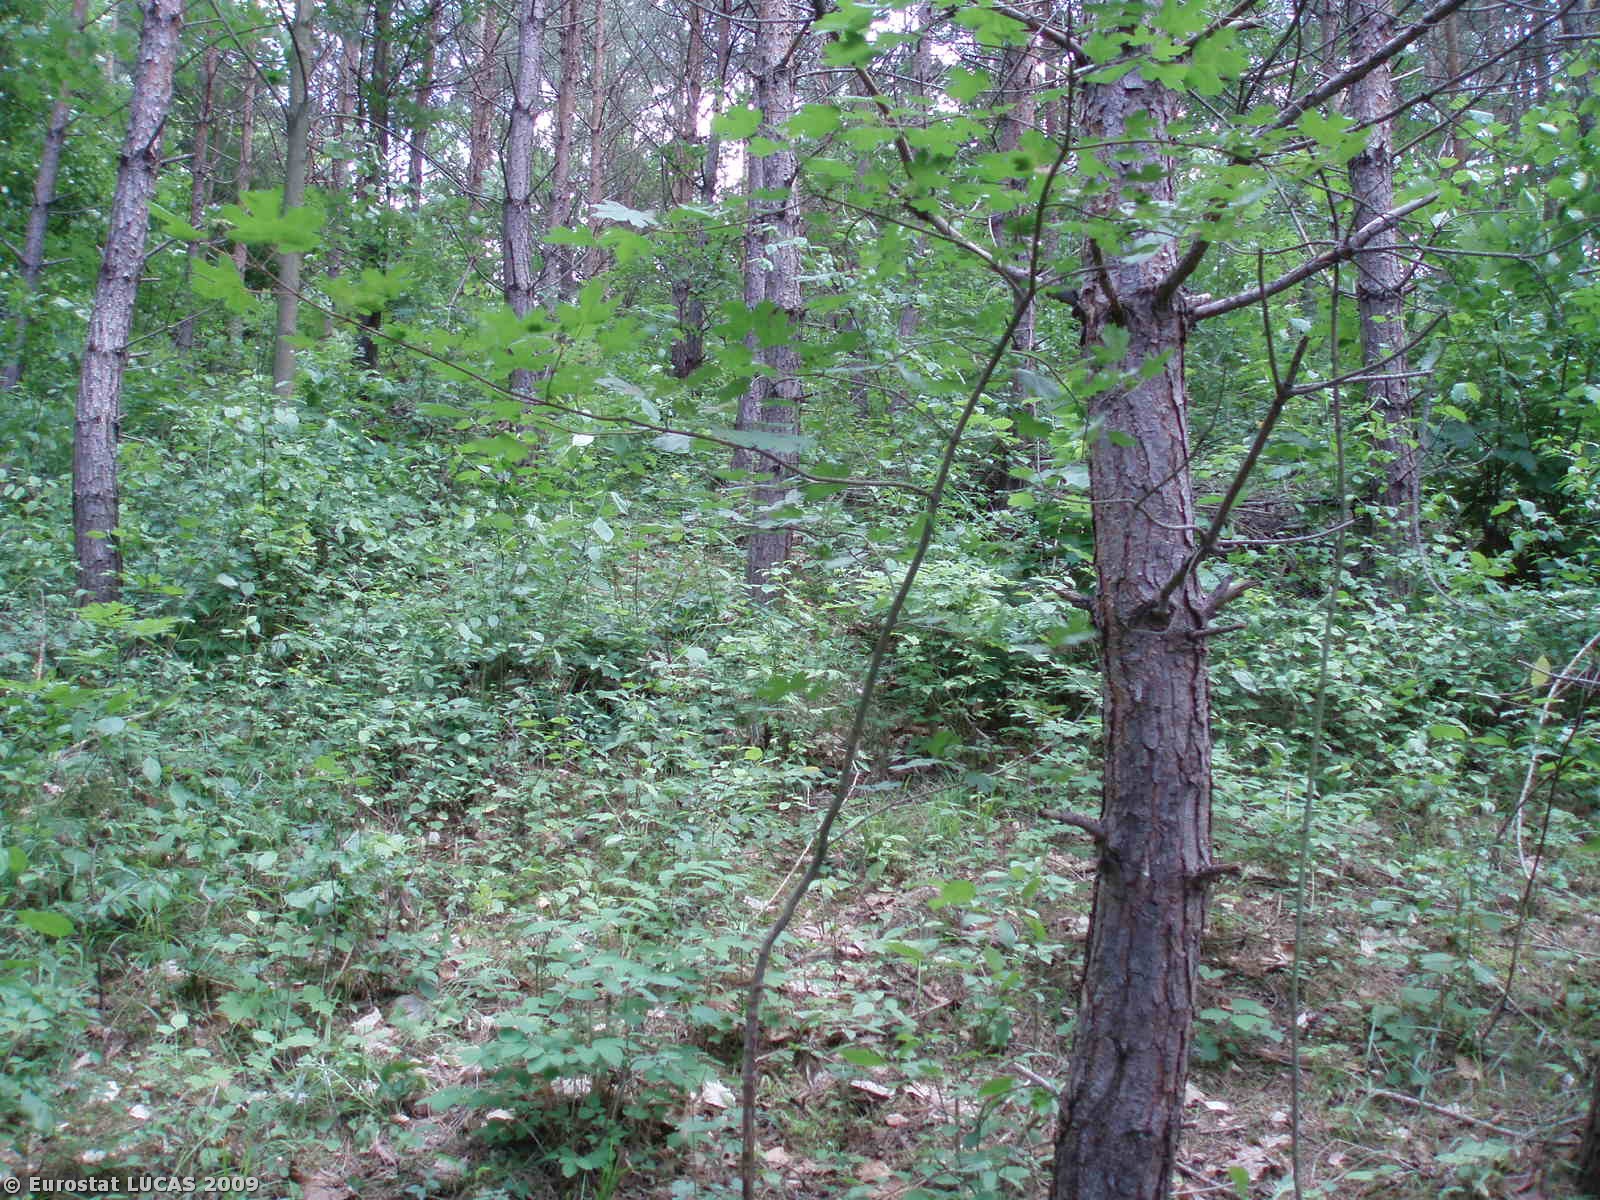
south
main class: Woodland
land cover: Coniferous woodland
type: hemiboreal forest and nemoral coniferous forest and mixed broadleaved-coniferous forest
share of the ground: > 75 %
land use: Forestry
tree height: > 5 m
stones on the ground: < 10 %
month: May
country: CZ
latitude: 49.9609
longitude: 14.2529
